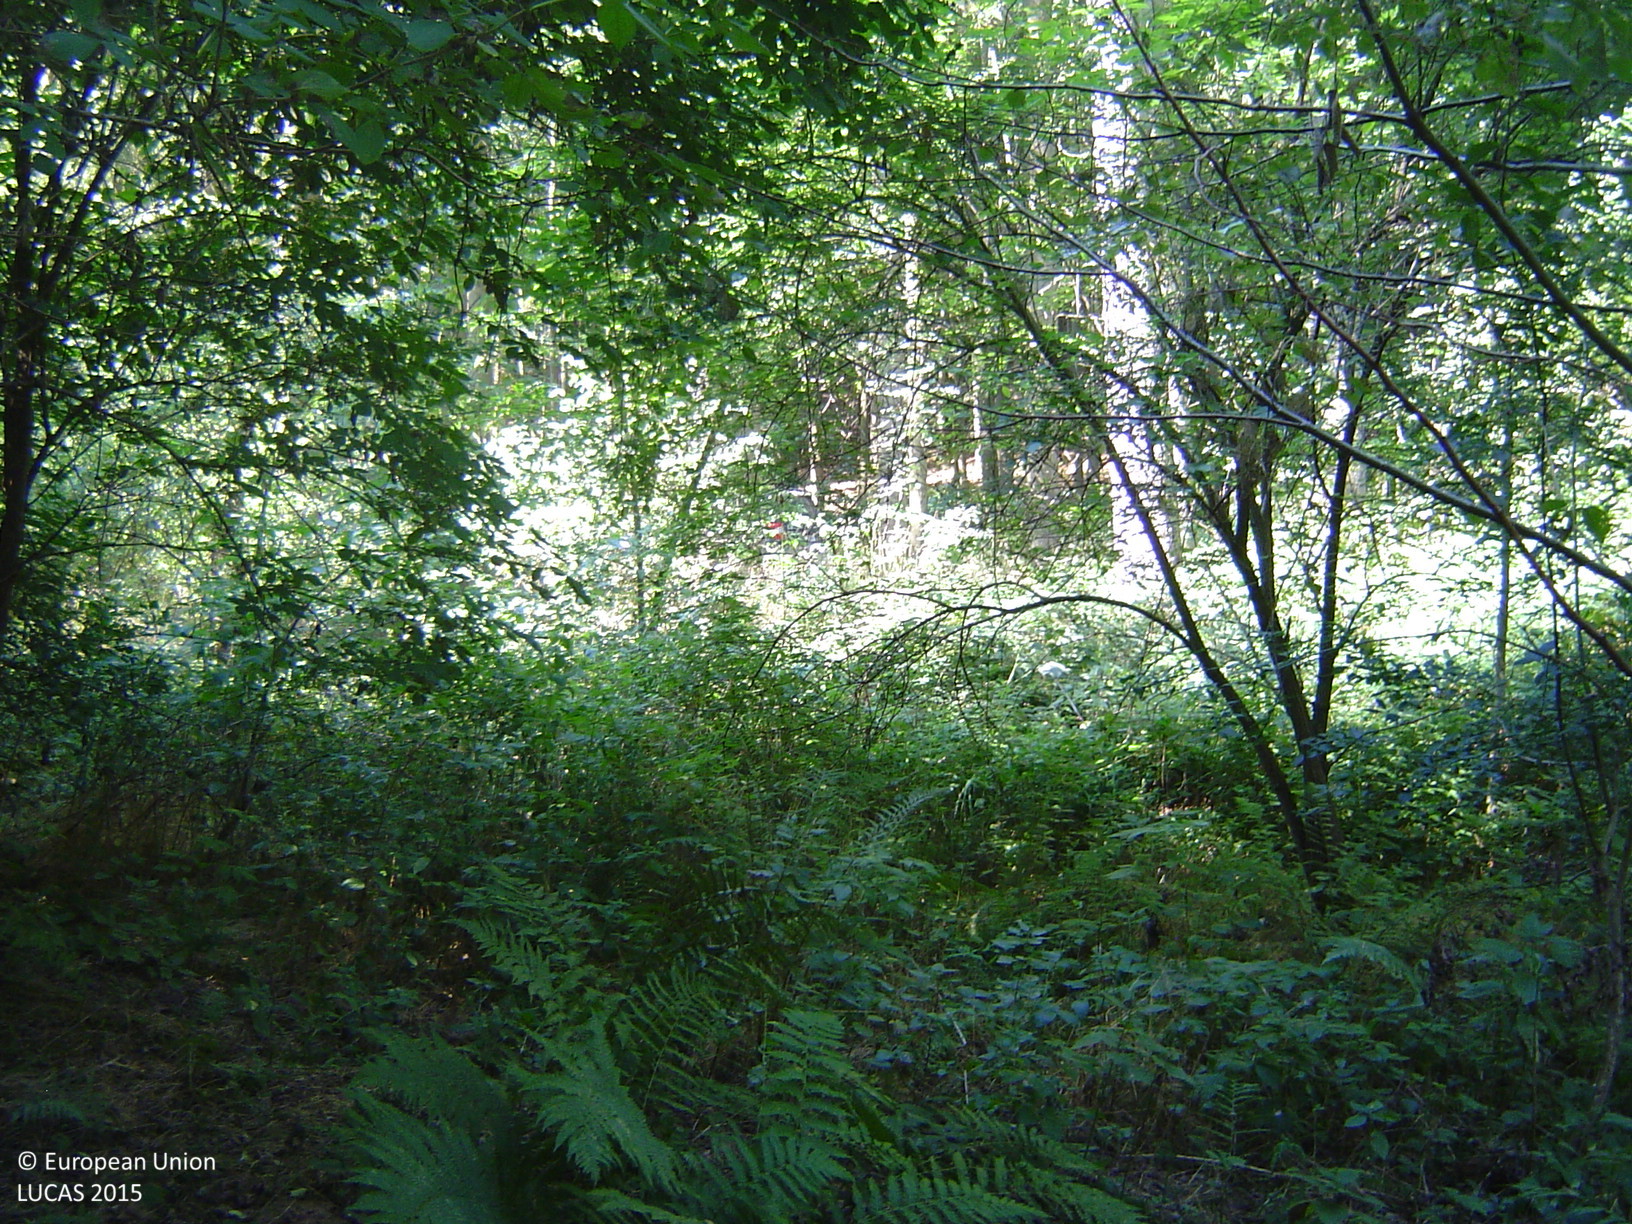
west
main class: Woodland
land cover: Broadleaved woodland
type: mesophytic deciduous forest
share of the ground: > 75 %
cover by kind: broadleaved forest trees 80 %, coniferous forest trees 10 %, shrubs 10 %
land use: Forestry
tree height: > 5 m
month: August
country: CZ
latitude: 49.6315
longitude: 14.3903
